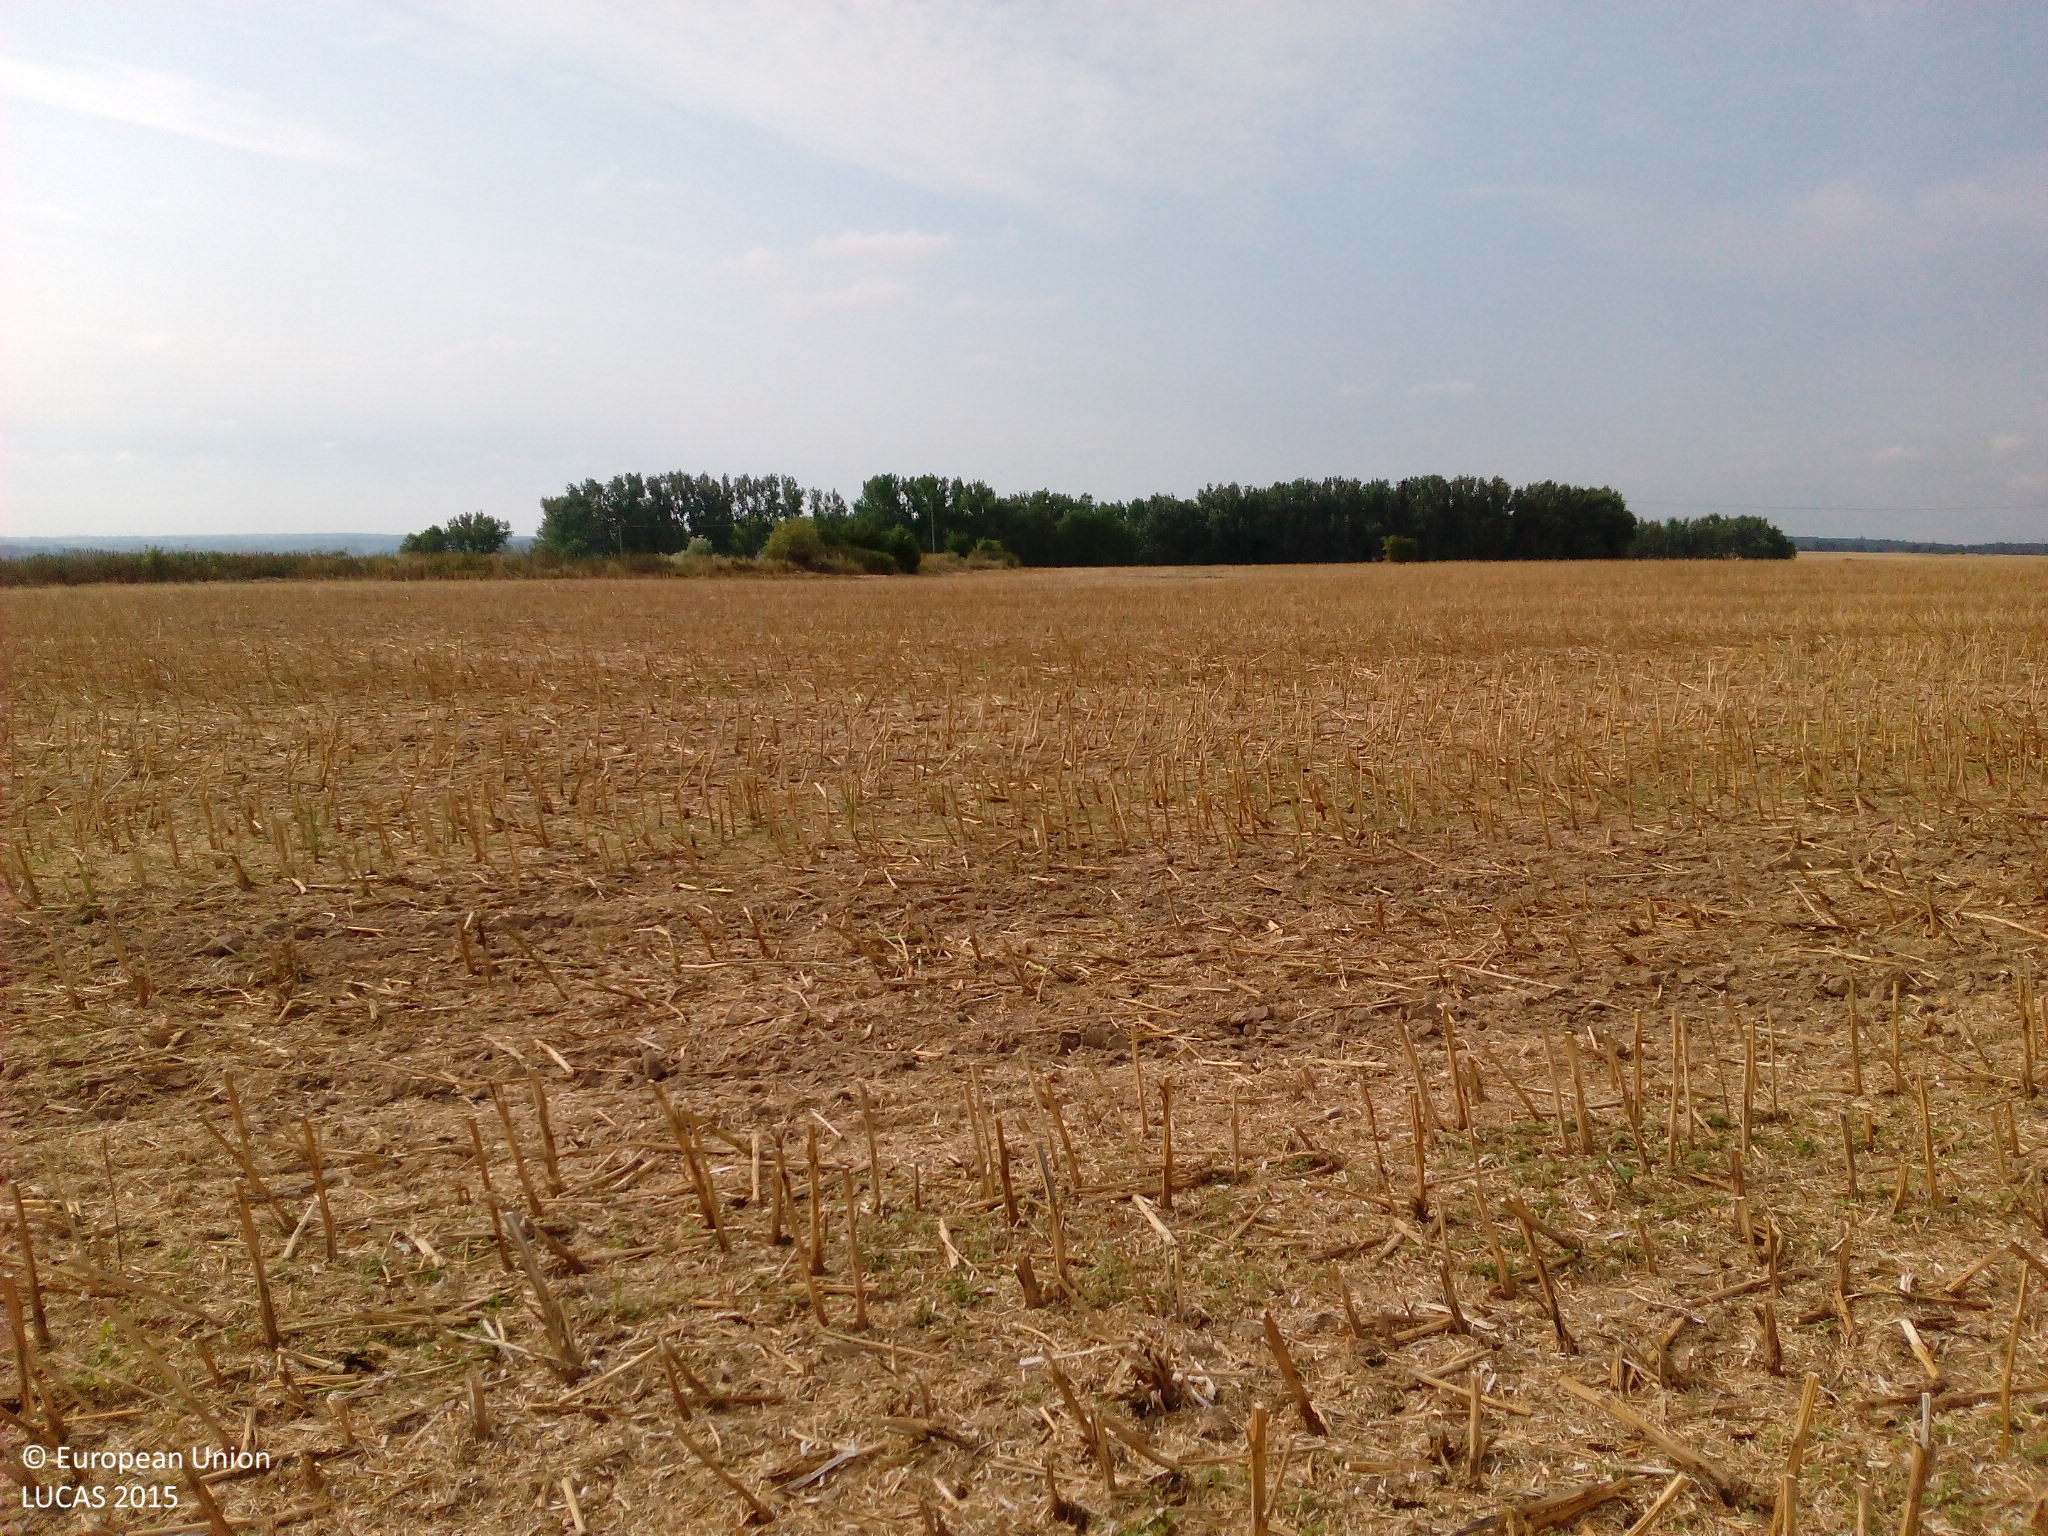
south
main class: Cropland
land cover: Rape and turnip rape
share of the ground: < 10 %
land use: Agriculture (excluding fallow land and kitchen gardens)
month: August
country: DE
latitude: 53.5931
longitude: 13.2177
